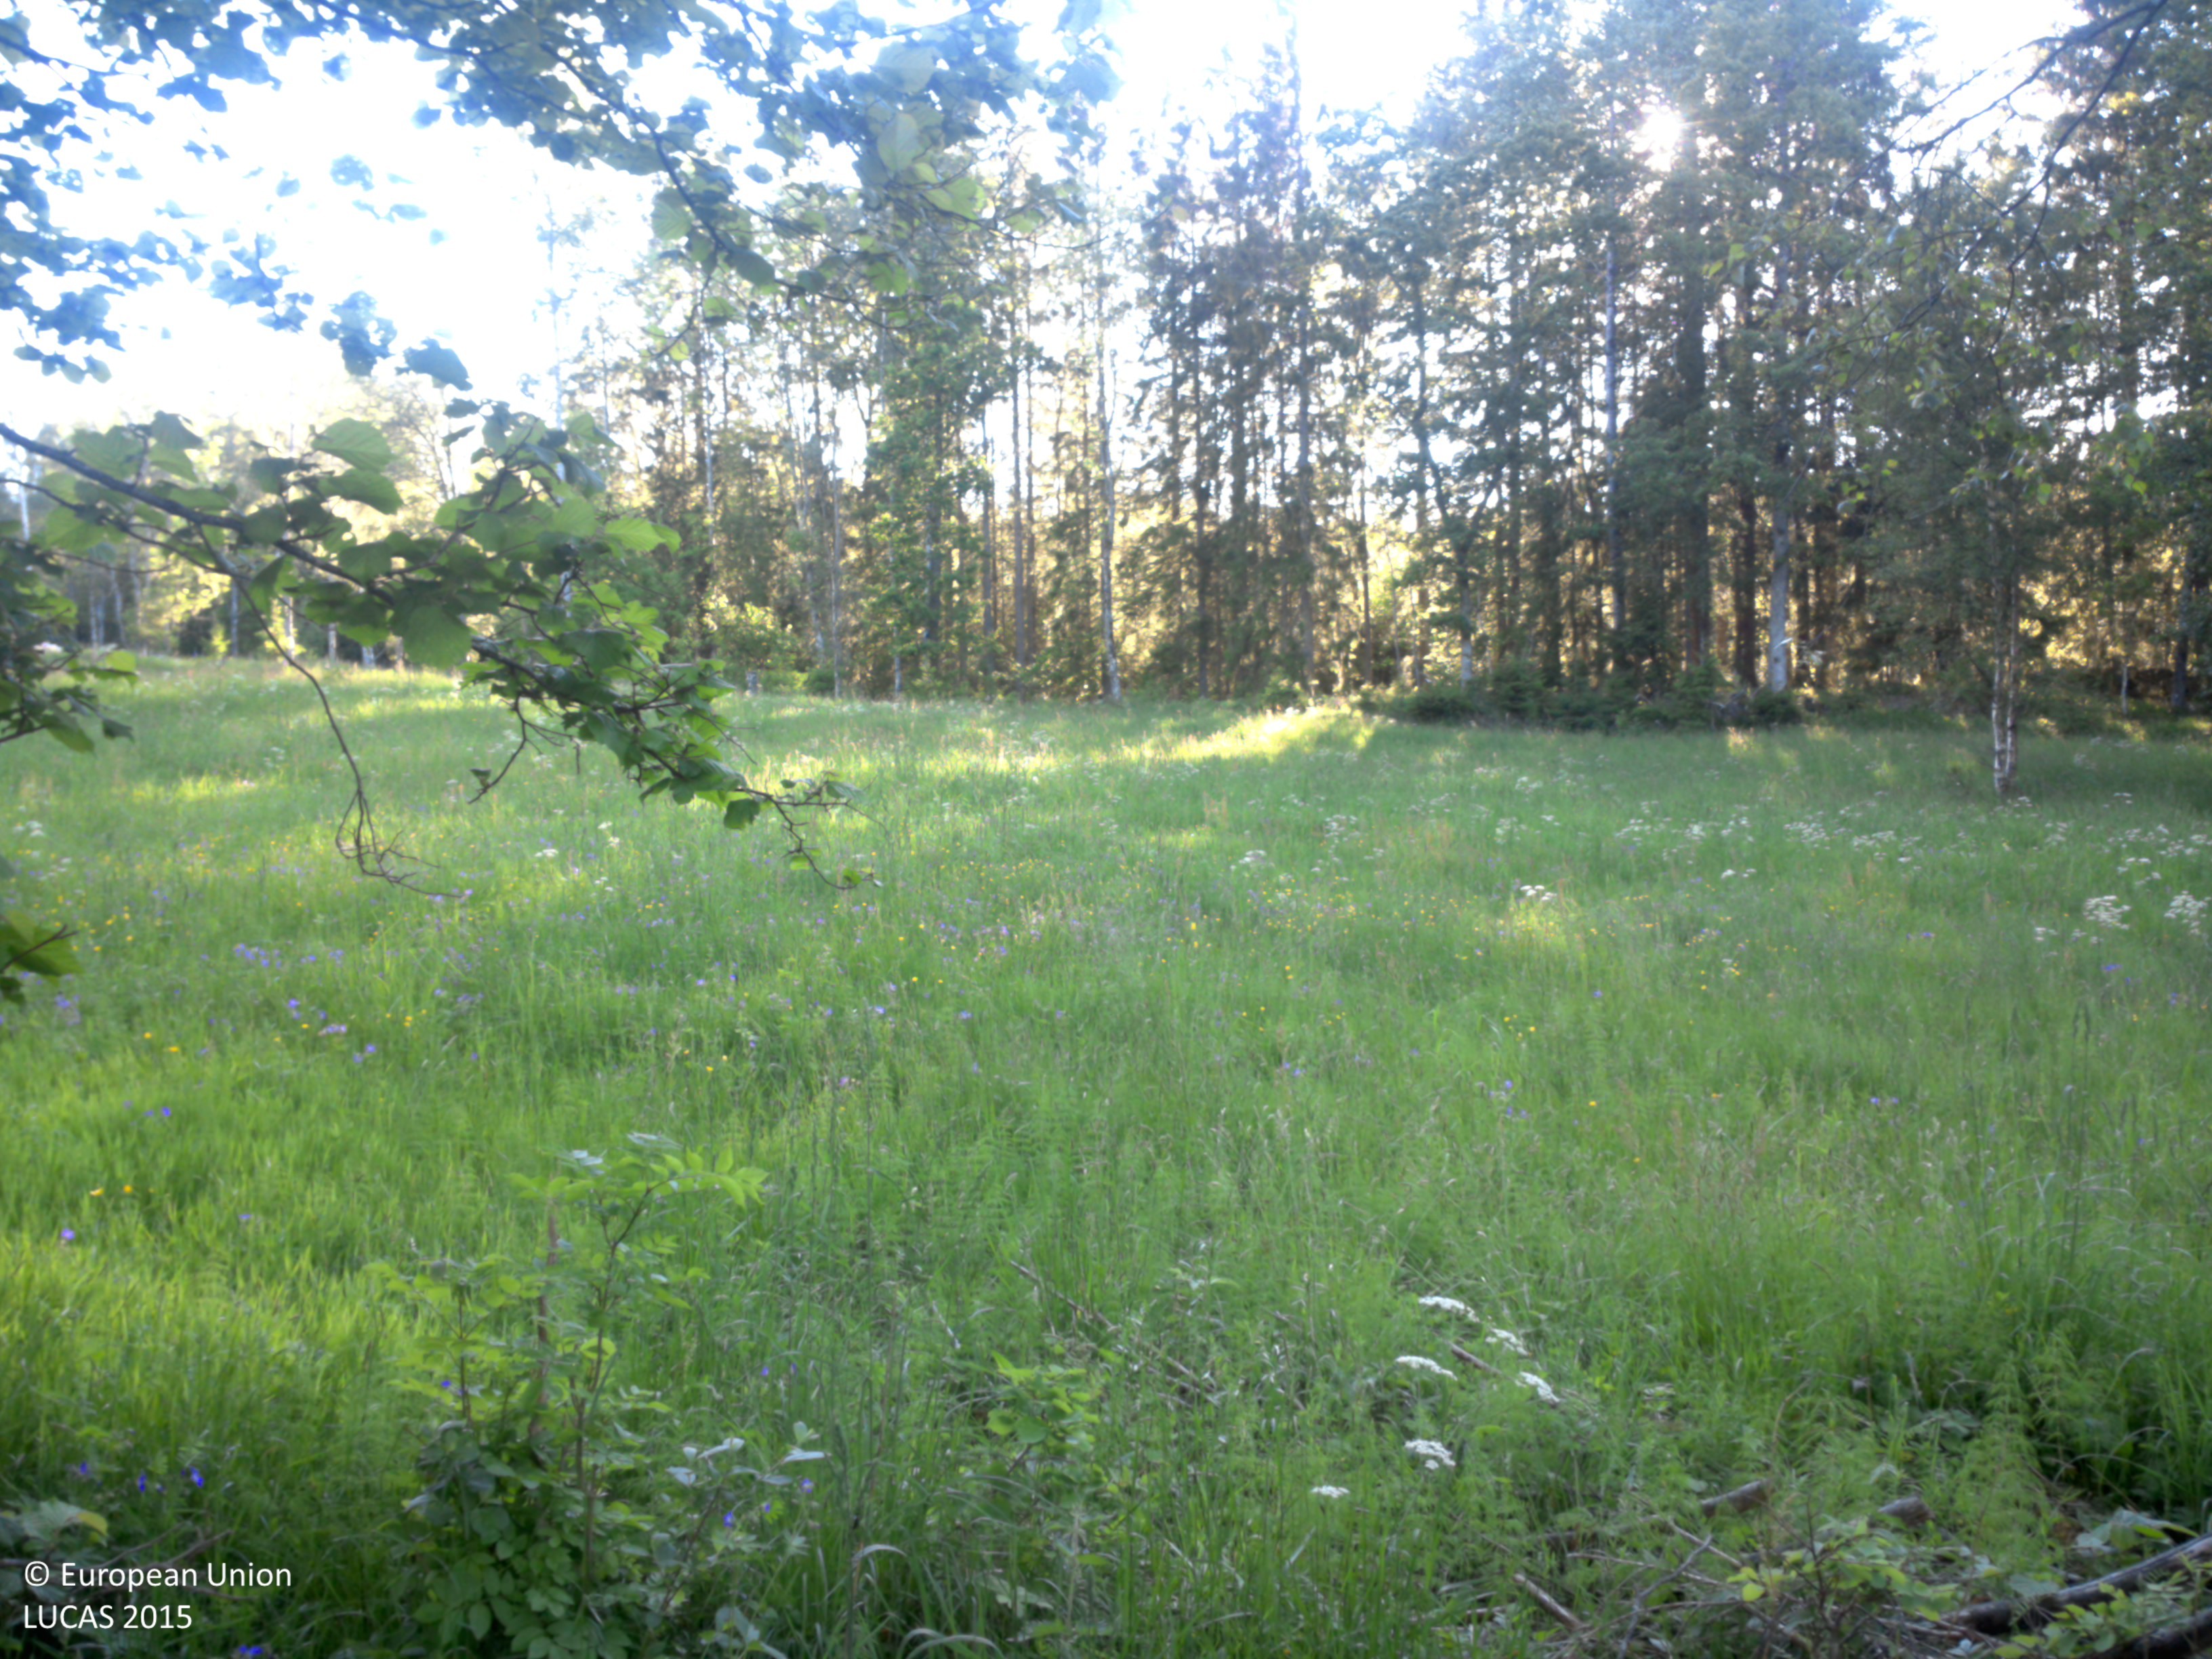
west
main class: Woodland
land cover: Broadleaved woodland
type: hemiboreal forest and nemoral coniferous forest and mixed broadleaved-coniferous forest
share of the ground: 10 - 25 %
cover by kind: herbaceous plants 70 %, broadleaved forest trees 15 %, shrubs 15 %
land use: Forestry
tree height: > 5 m
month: June
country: SE
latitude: 58.9619
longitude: 11.8909
